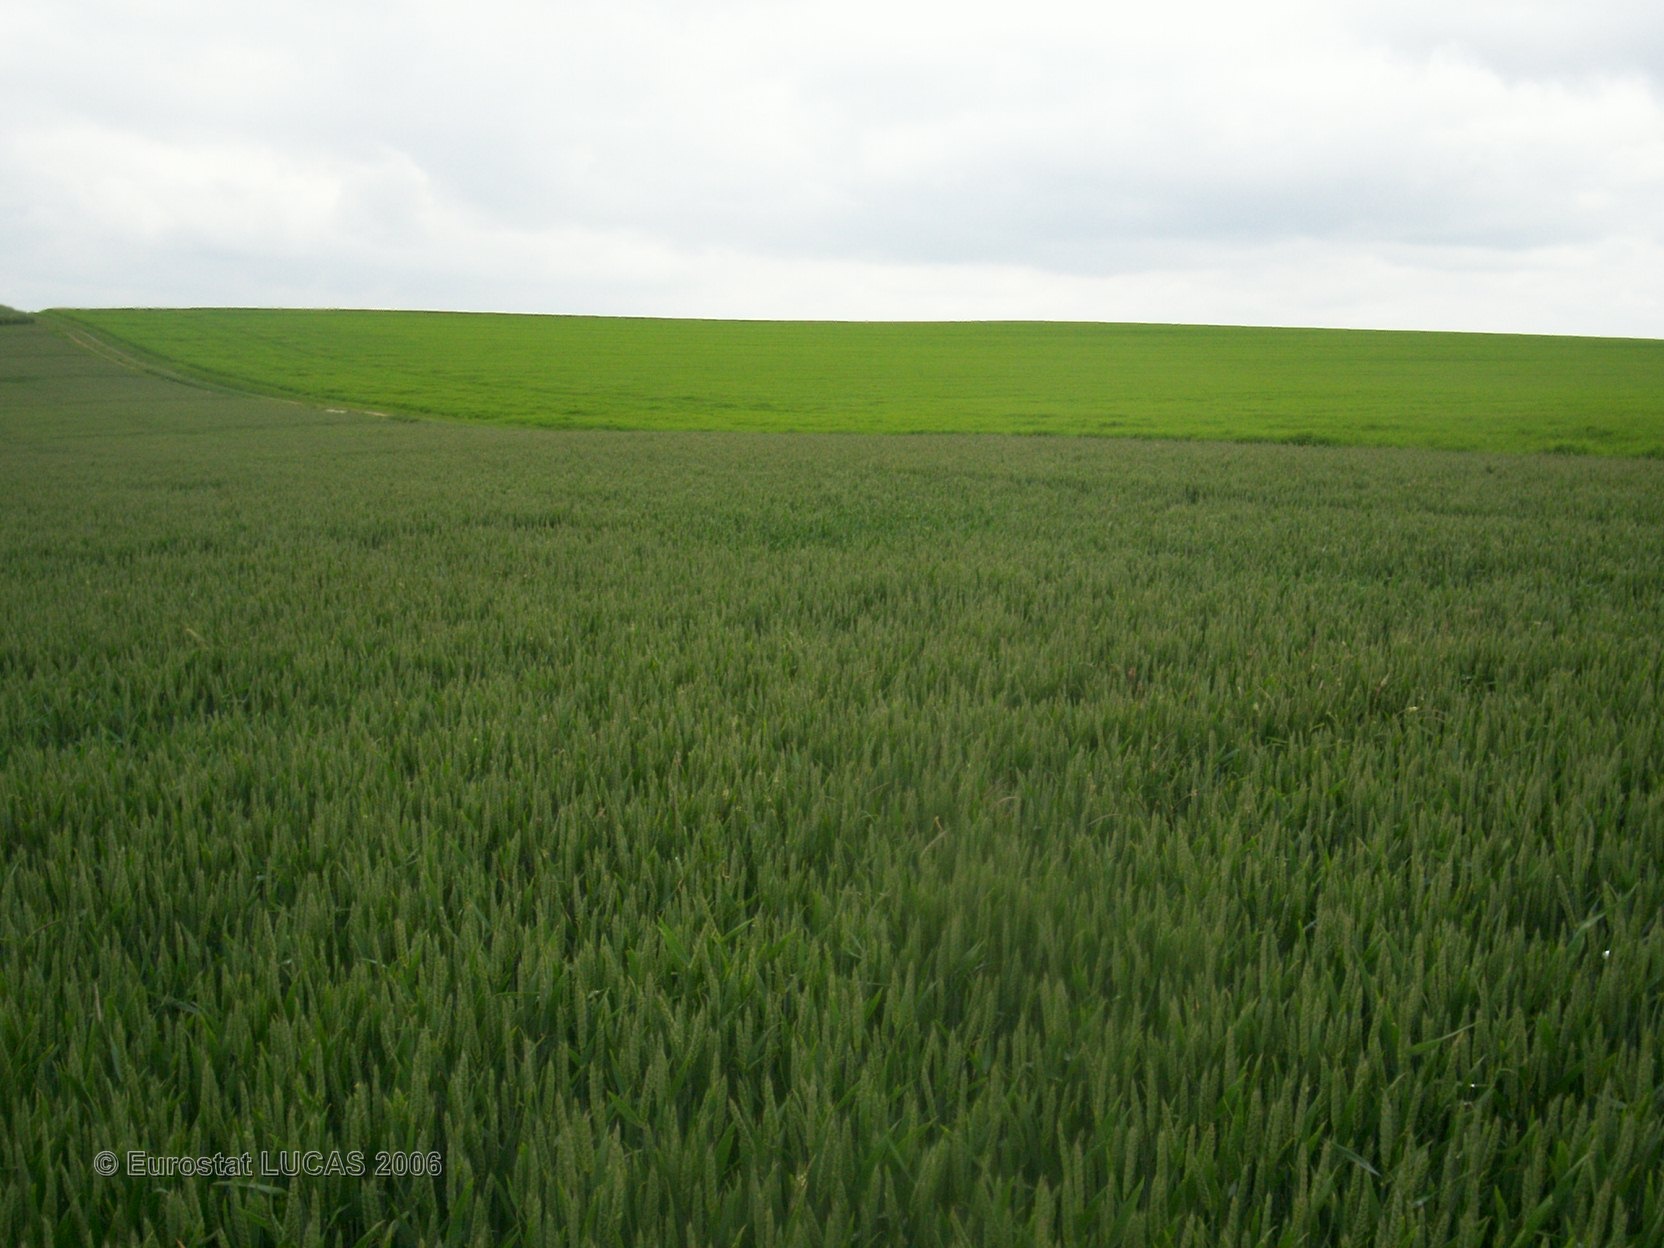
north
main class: Cropland
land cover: Common wheat
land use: Agriculture (excluding fallow land and kitchen gardens)
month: June
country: FR
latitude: 48.5889
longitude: 4.4520
